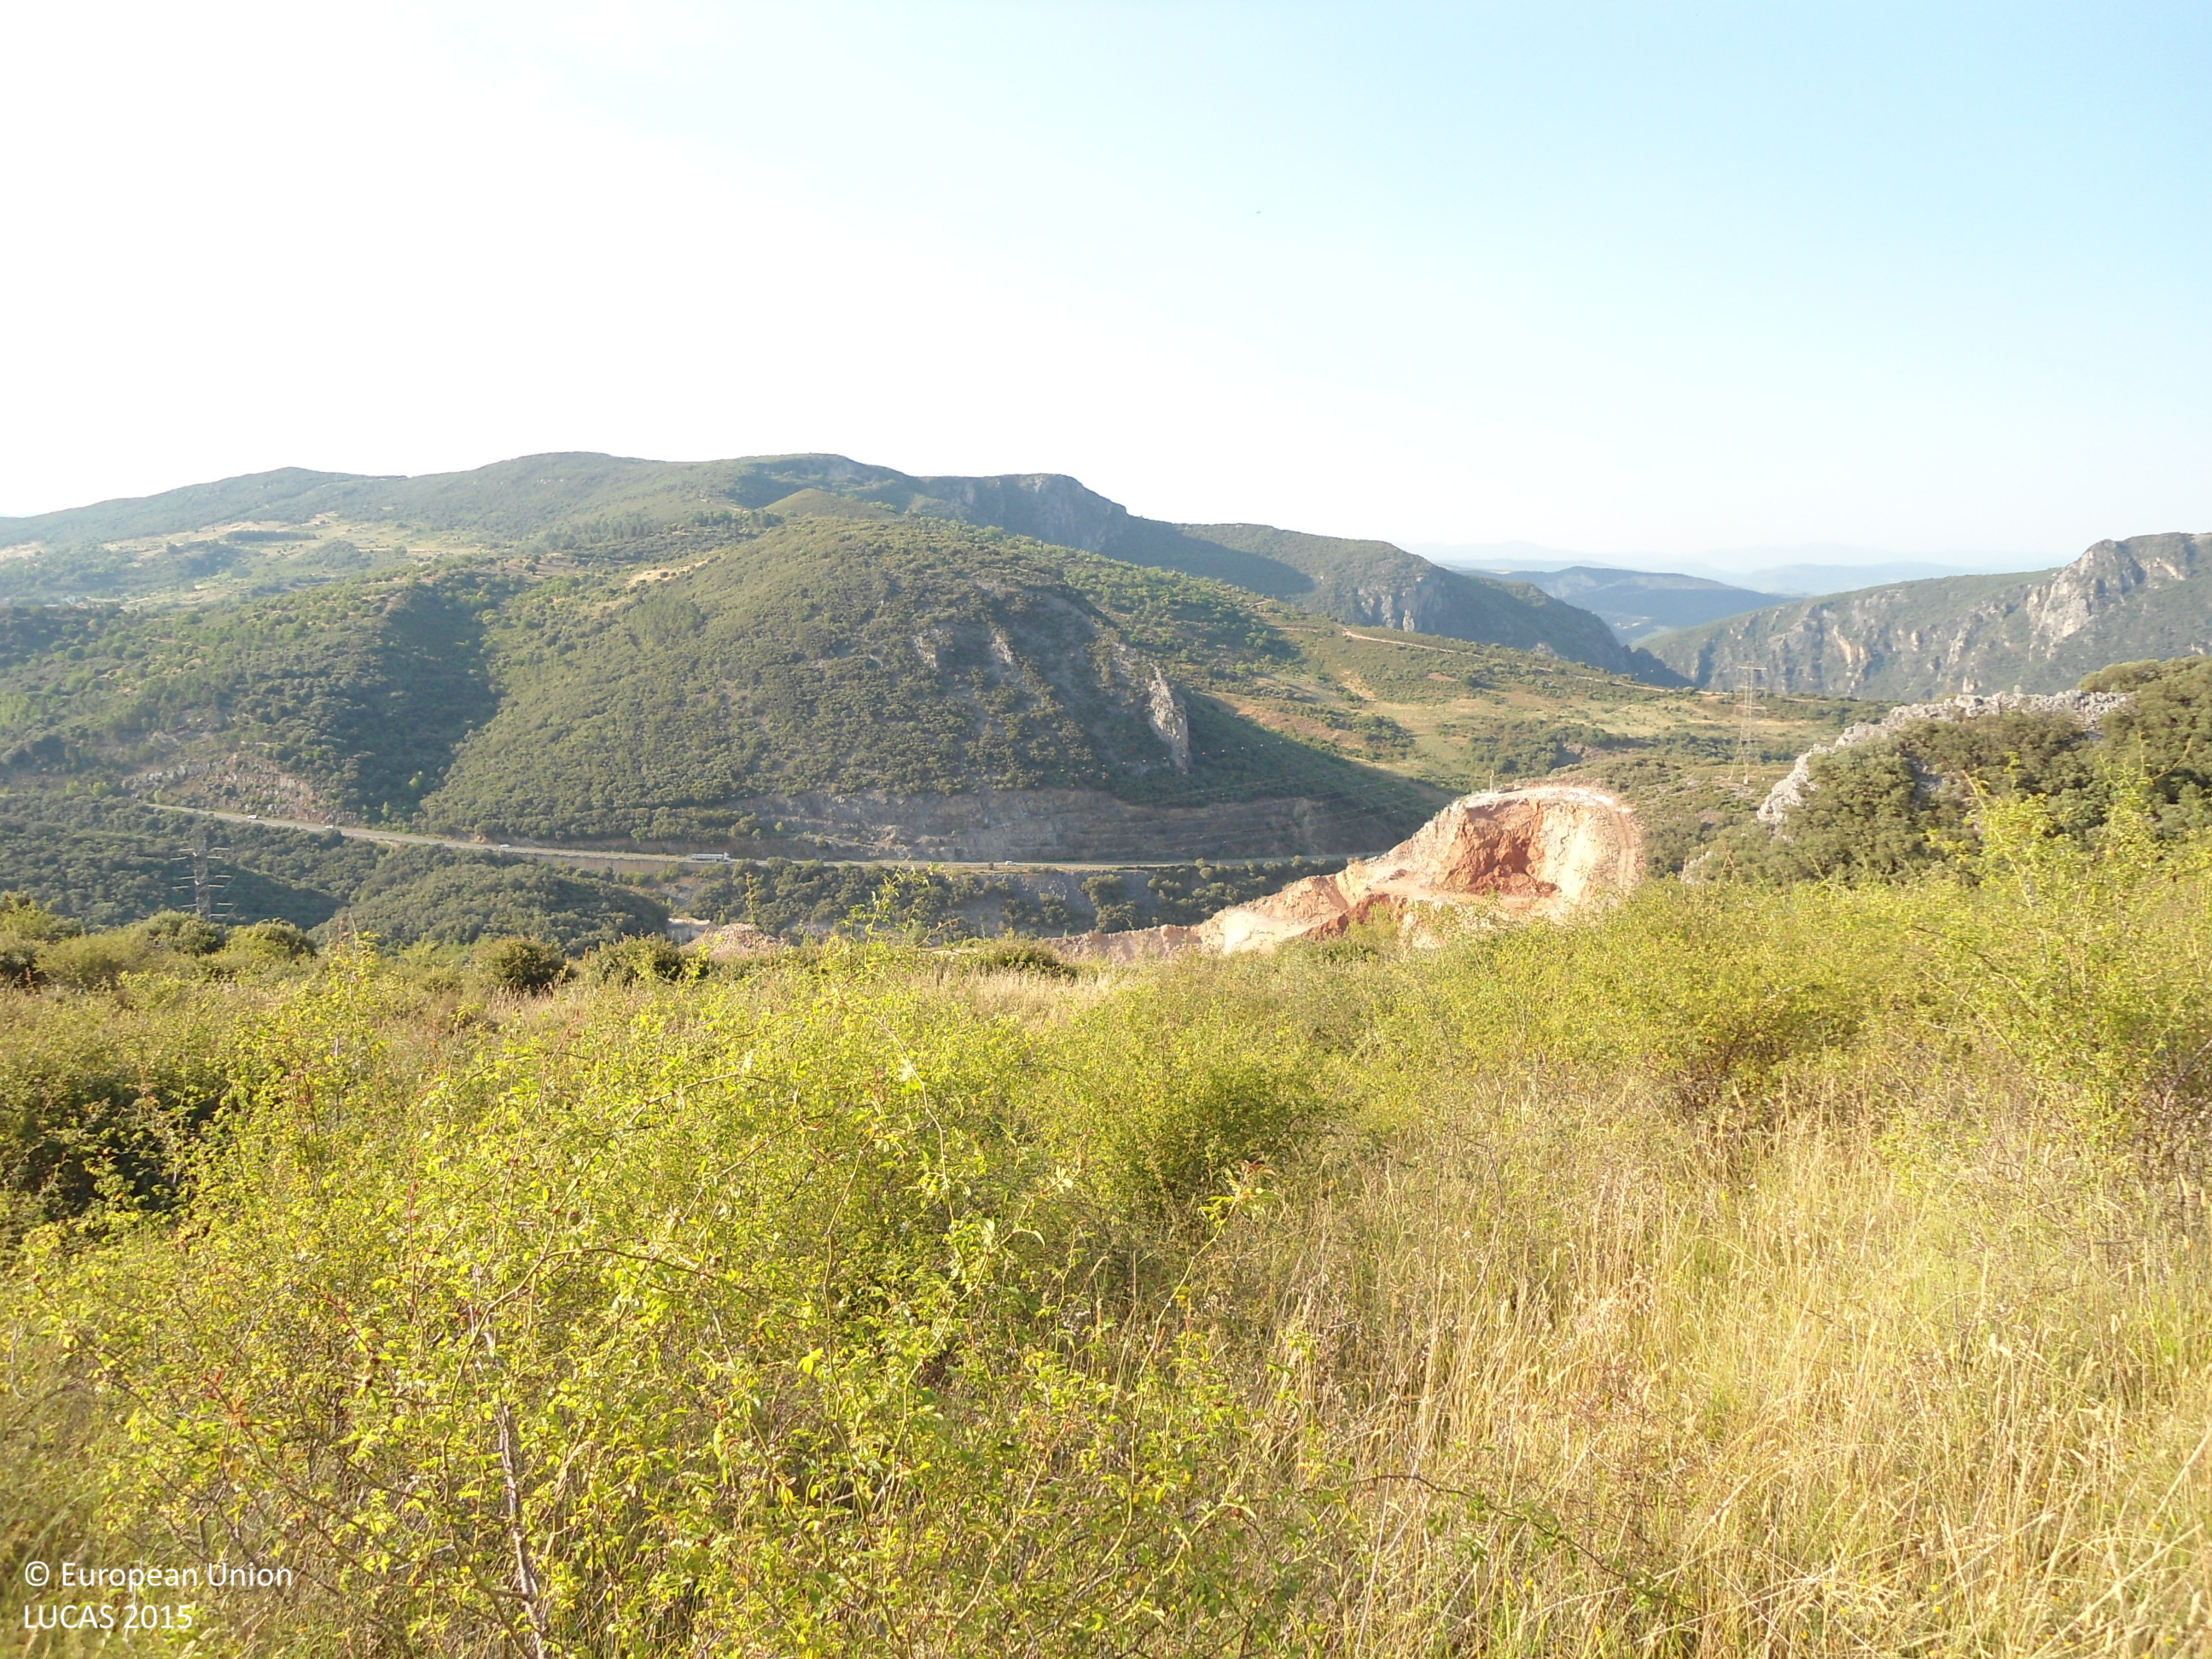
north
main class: Shrubland
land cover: Shrubland without tree cover
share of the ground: > 75 %
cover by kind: shrubs 85 %, herbaceous plants 15 %
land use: Semi-natural and natural areas not in use
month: June
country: ES
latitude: 42.4642
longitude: -6.8468
